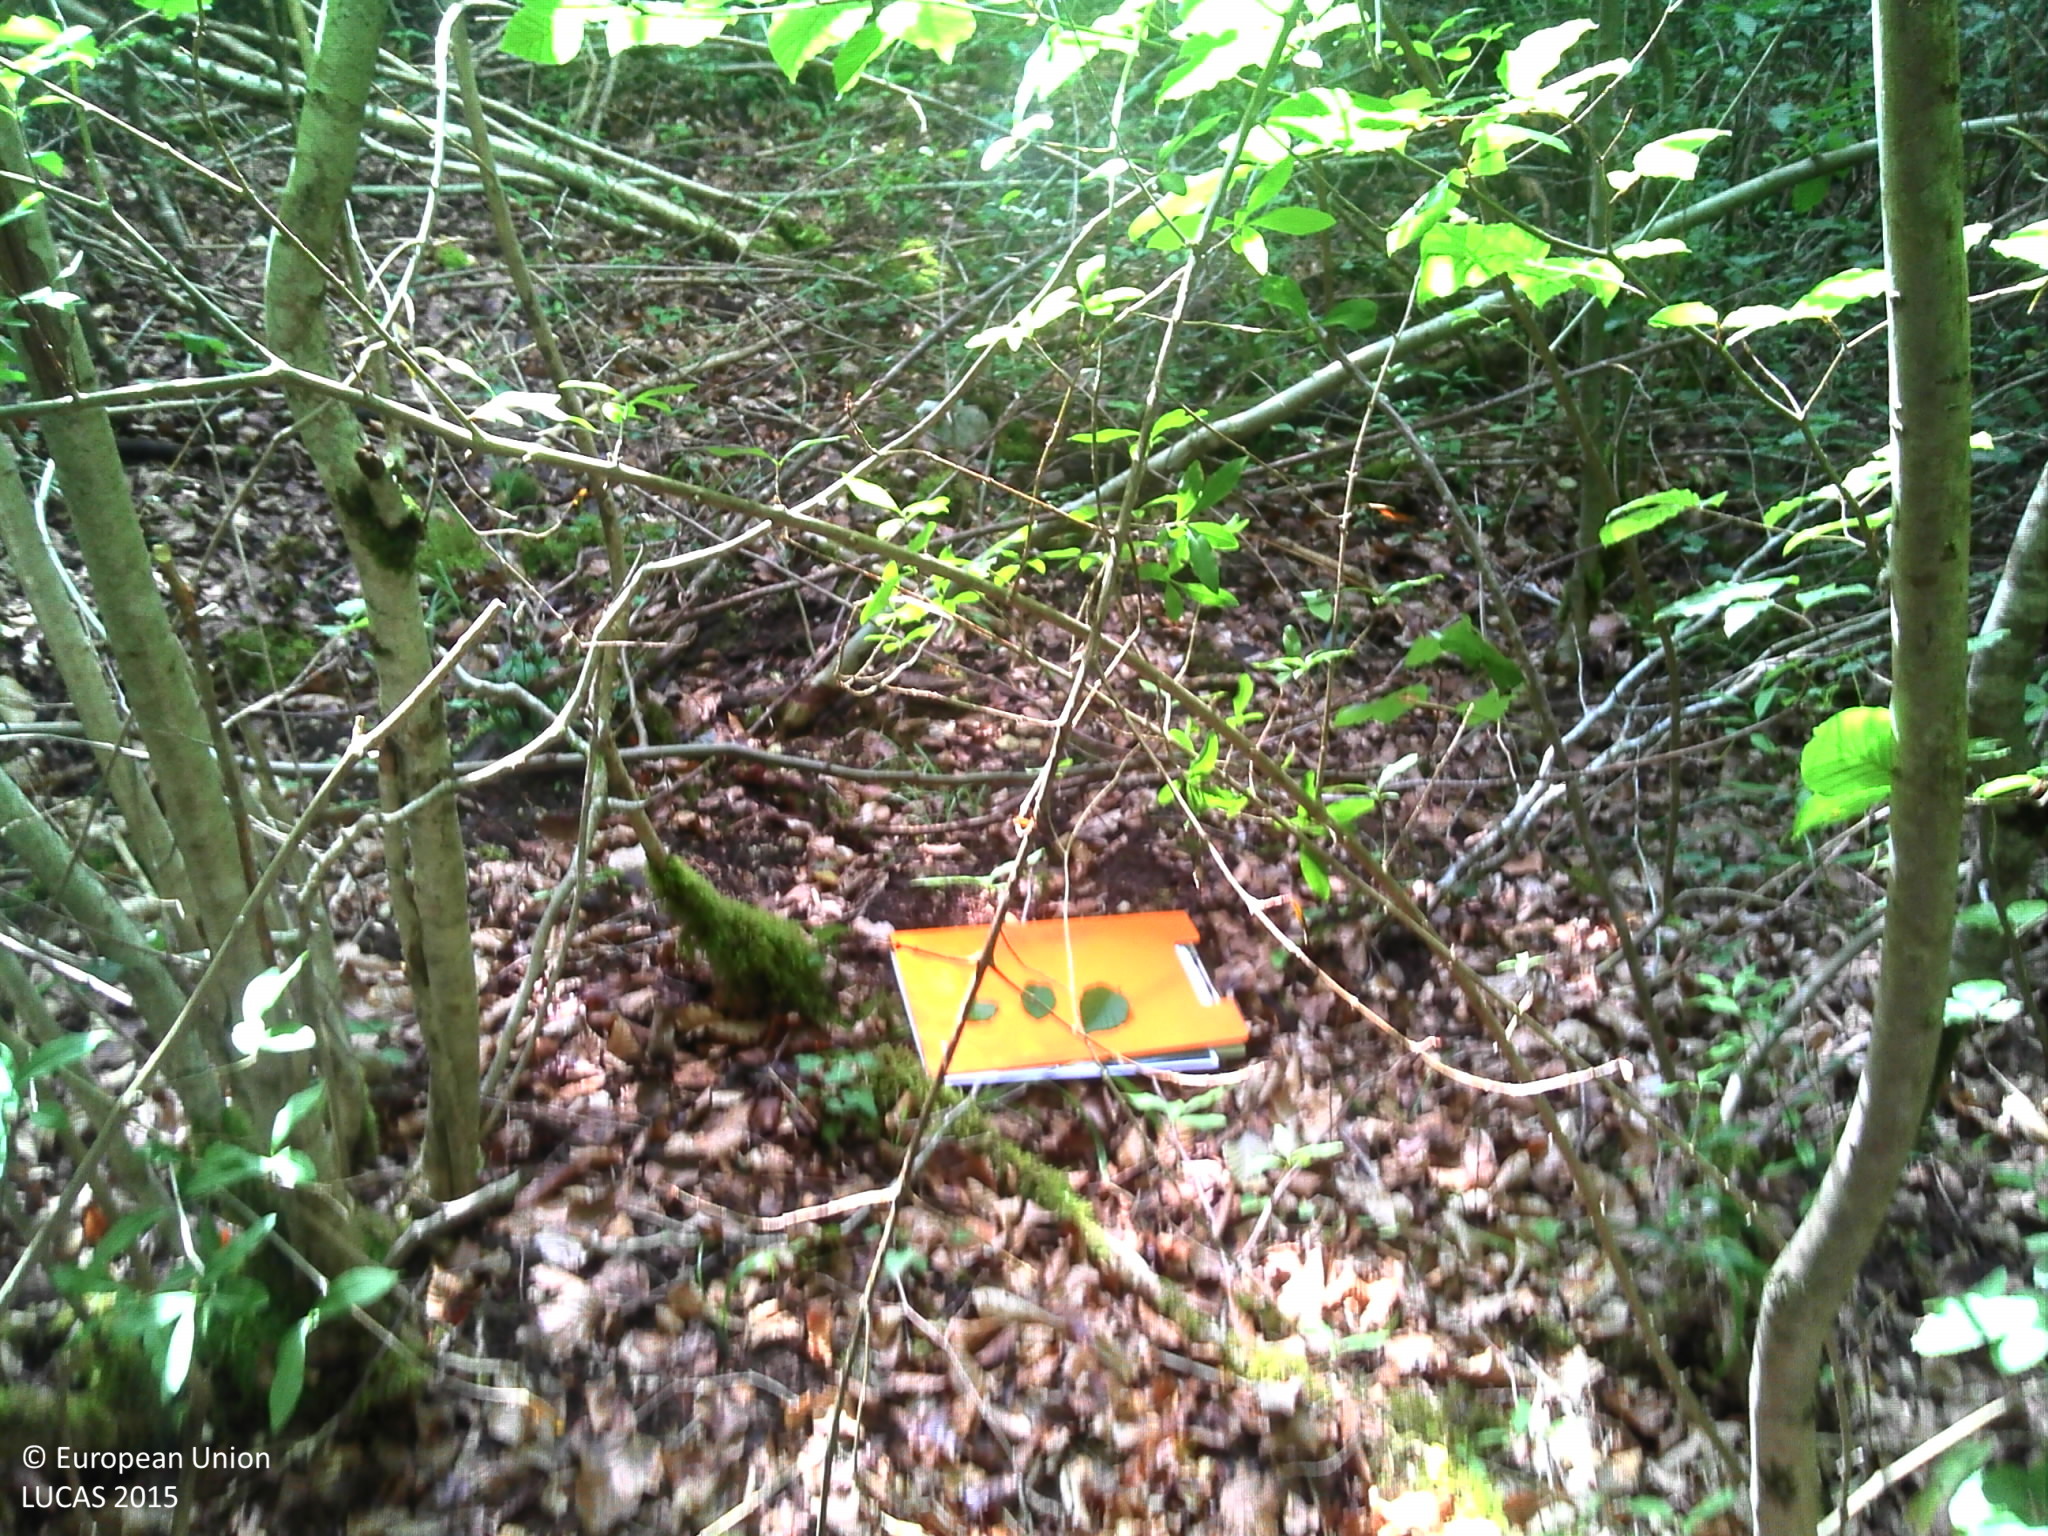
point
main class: Woodland
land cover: Broadleaved woodland
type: mesophytic deciduous forest
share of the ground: > 75 %
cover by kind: broadleaved forest trees 90 %, herbaceous plants 5 %, lichens and mosses 5 %
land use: Forestry
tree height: < 5 m
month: August
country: FR
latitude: 47.8045
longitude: 5.0191
